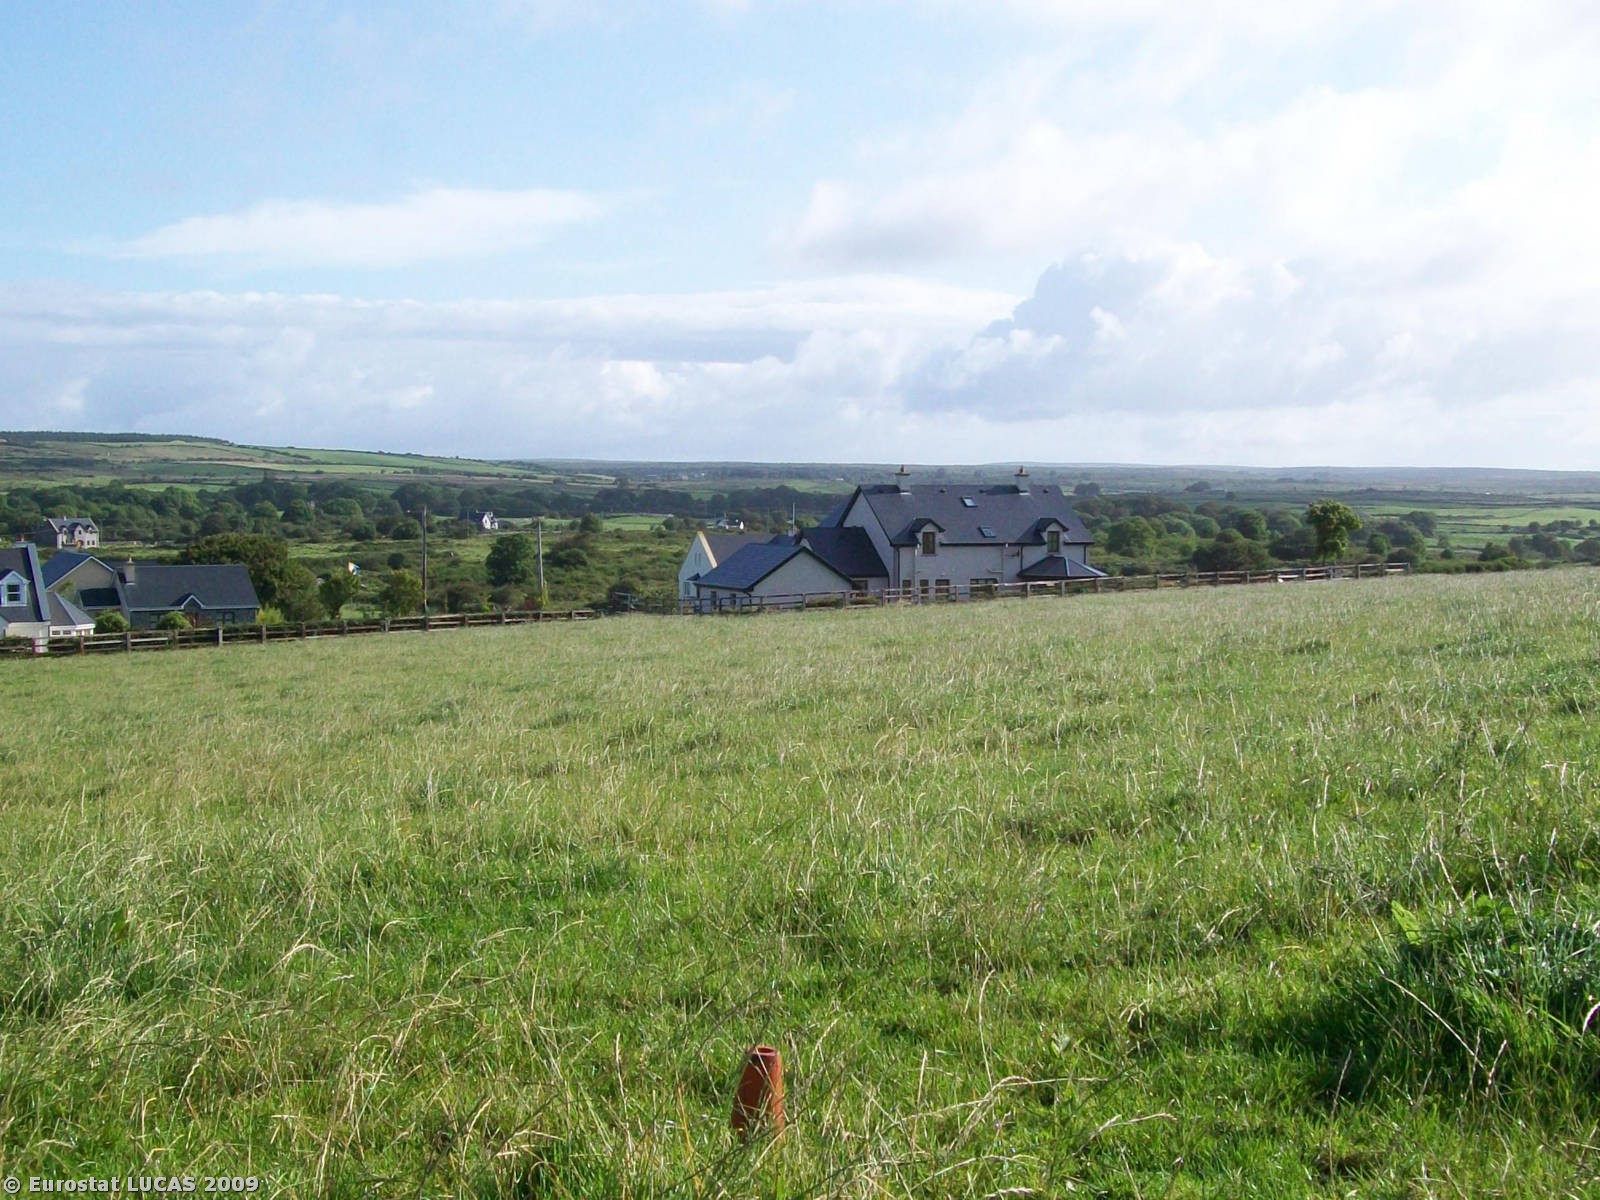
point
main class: Grassland
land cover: Grassland without tree/shrub cover
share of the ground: > 75 %
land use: Agriculture (excluding fallow land and kitchen gardens)
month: August
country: IE
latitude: 52.9890
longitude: -9.2148
